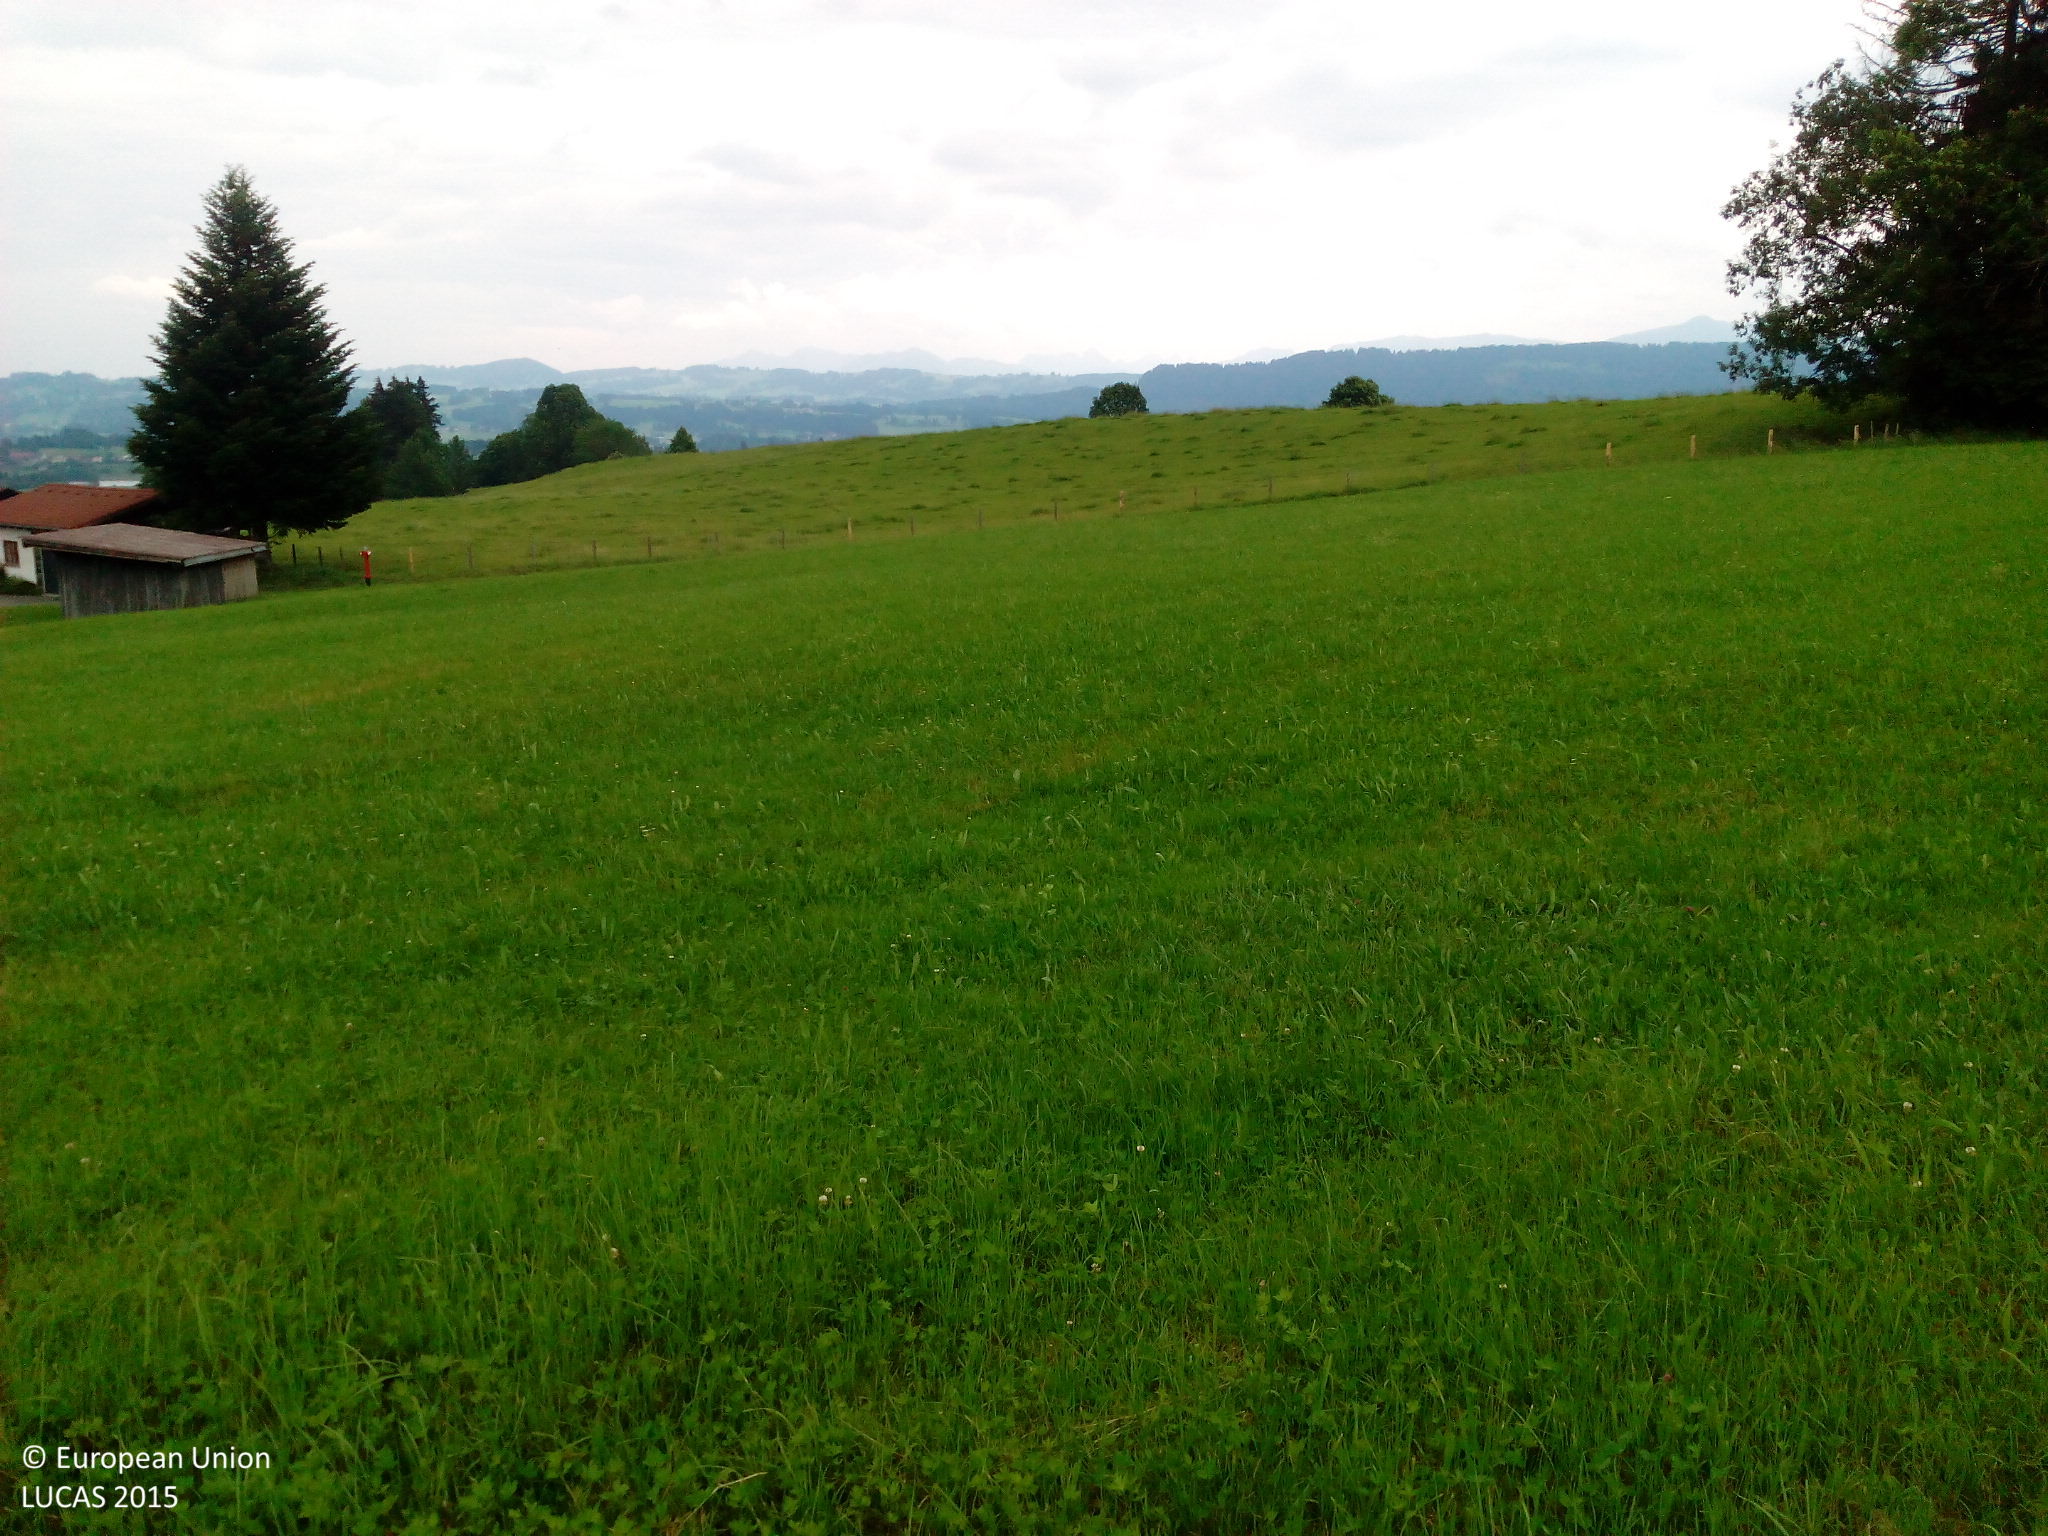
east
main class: Grassland
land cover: Grassland without tree/shrub cover
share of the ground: > 75 %
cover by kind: herbaceous plants 100 %
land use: Agriculture (excluding fallow land and kitchen gardens)
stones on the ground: < 10 %
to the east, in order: Grassland without tree/shrub cover; Artificial constructions in urban areas; Grassland without tree/shrub cover
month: June
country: DE
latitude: 47.6473
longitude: 10.2527
